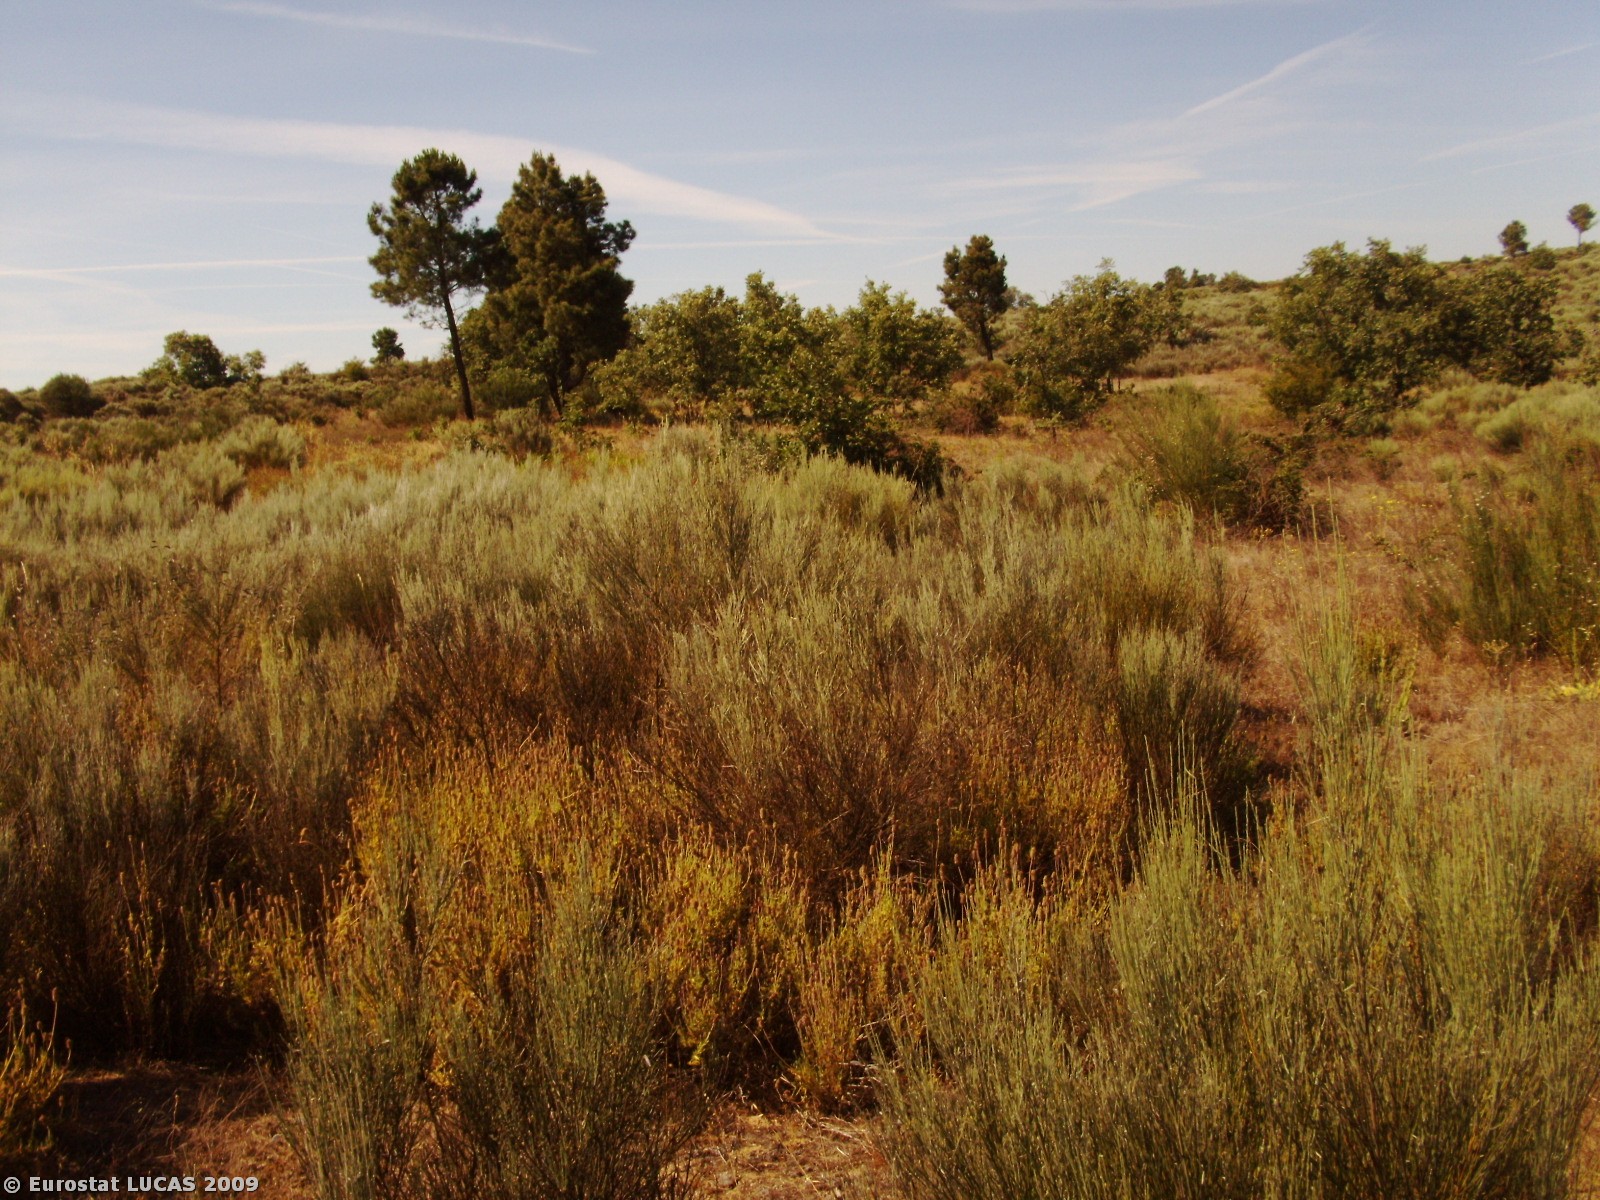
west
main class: Shrubland
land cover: Shrubland without tree cover
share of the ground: > 75 %
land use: Fallow land
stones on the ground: > 50 %
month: July
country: PT
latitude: 40.4556
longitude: -7.0684
